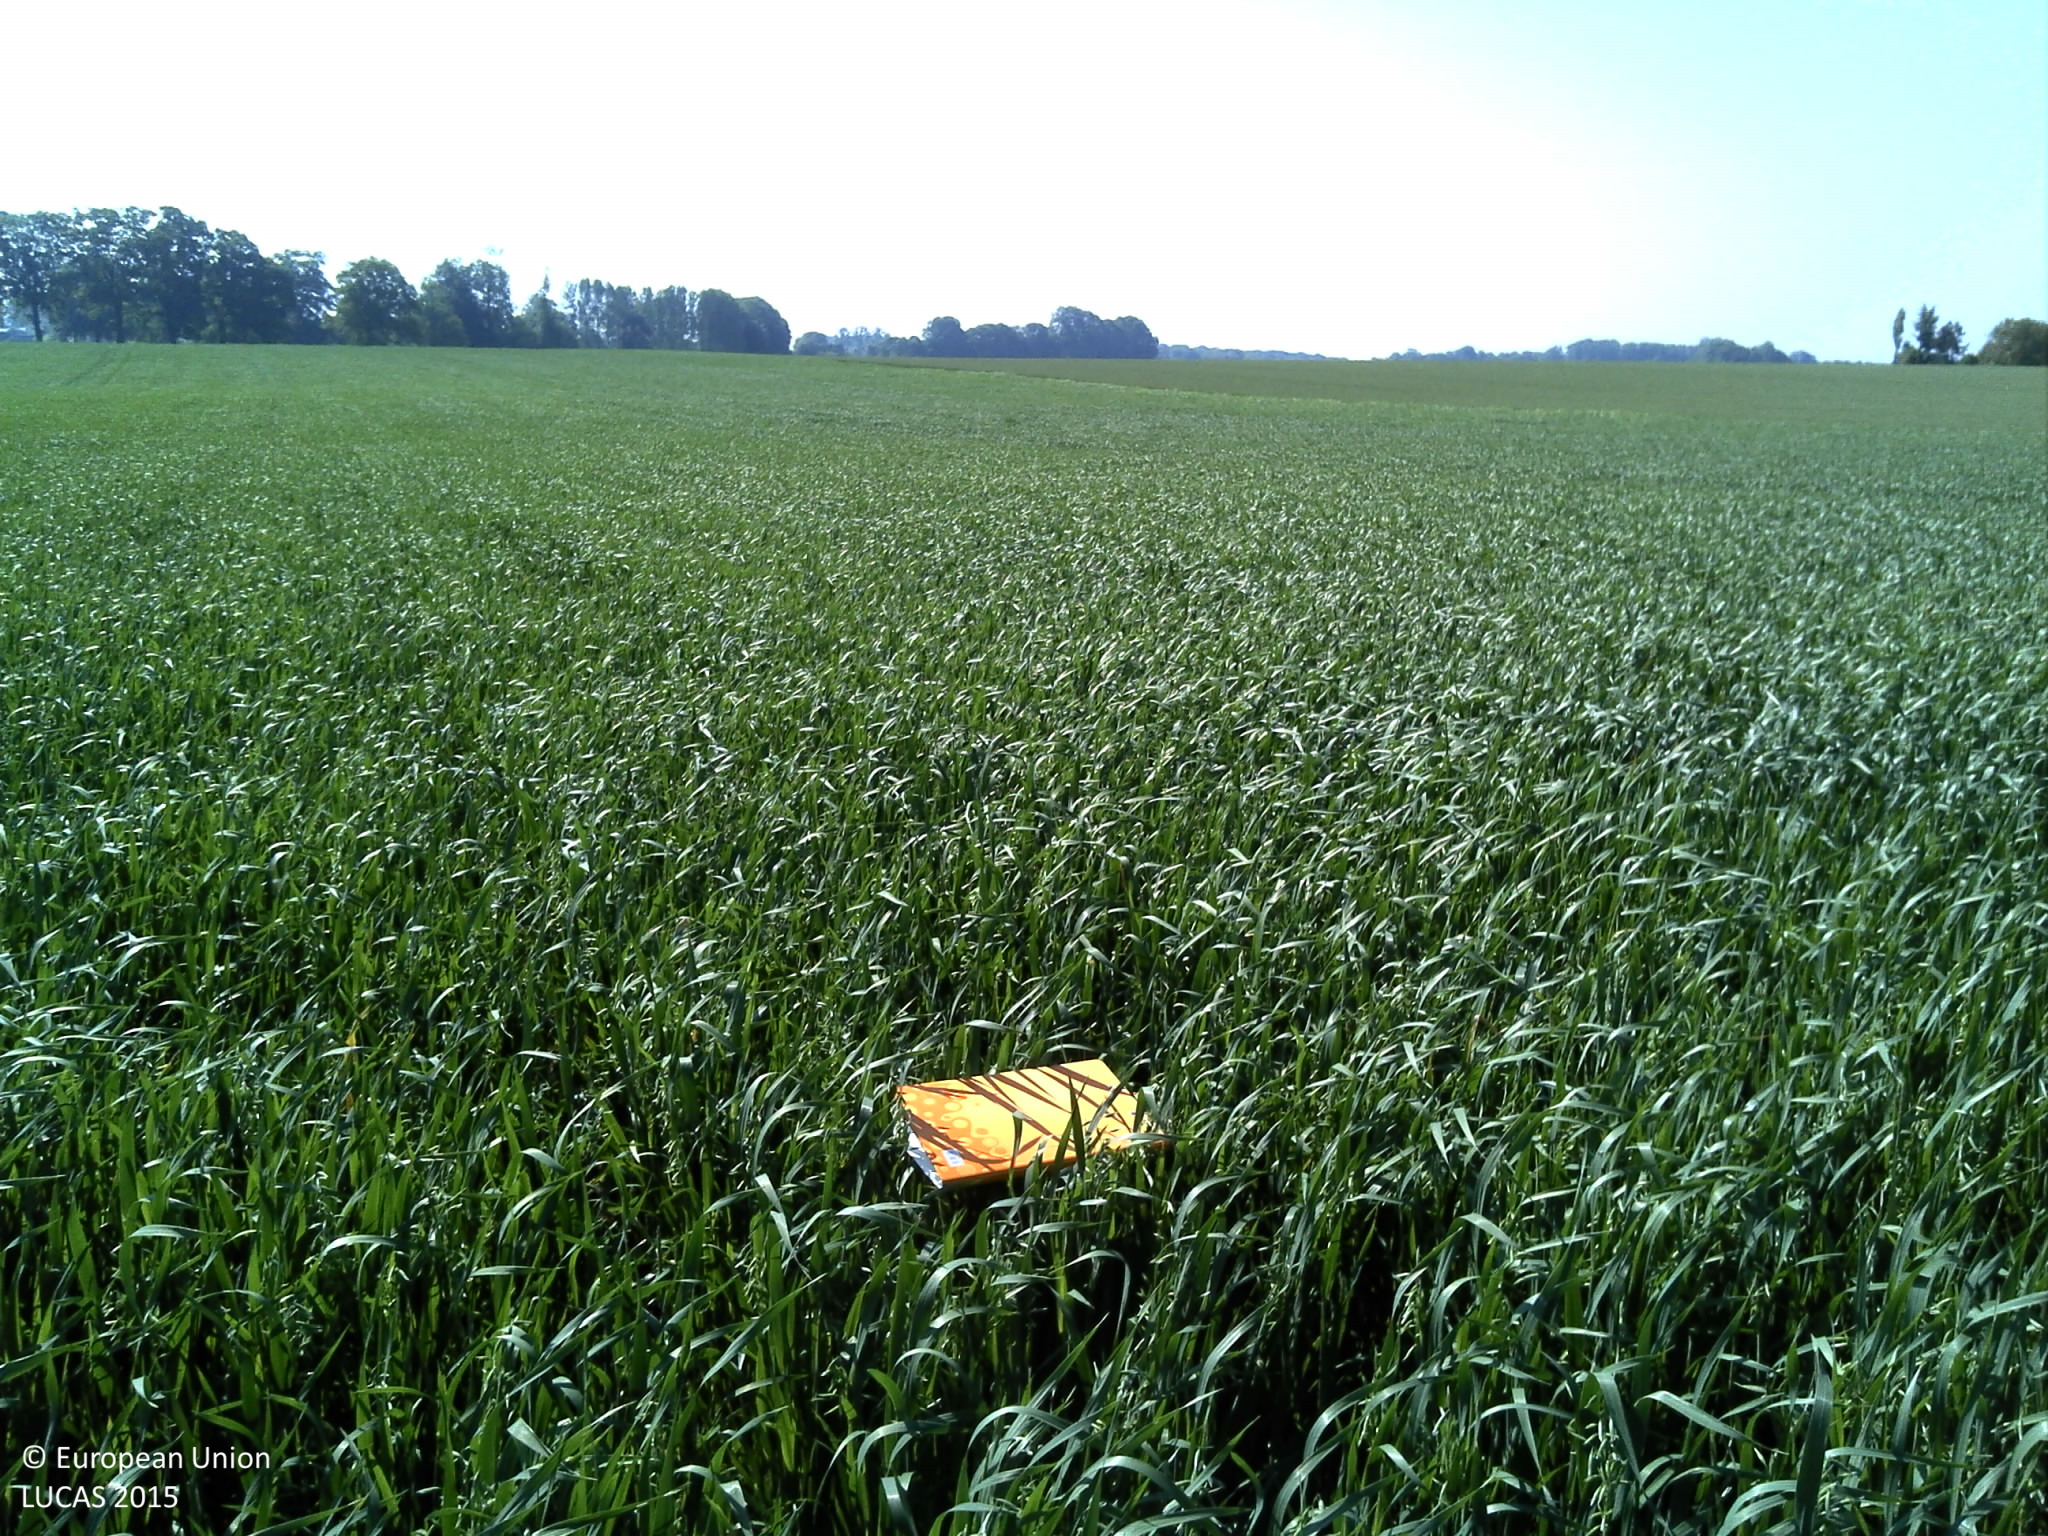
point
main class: Cropland
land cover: Oats
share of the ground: > 75 %
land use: Agriculture (excluding fallow land and kitchen gardens)
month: June
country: FR
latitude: 49.6346
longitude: 1.0751
